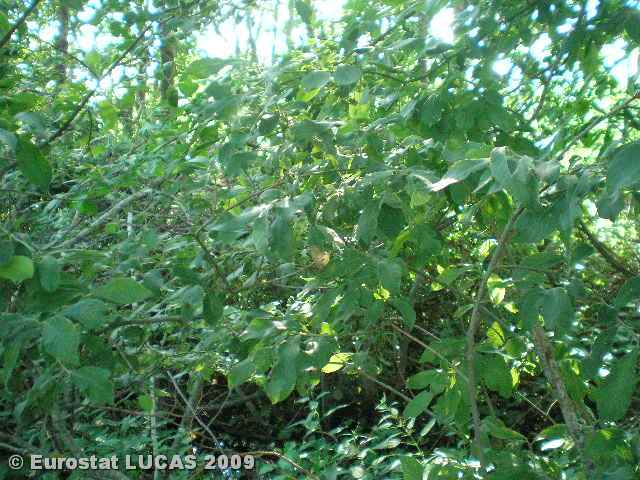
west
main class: Woodland
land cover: Broadleaved woodland
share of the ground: > 75 %
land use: Agriculture (excluding fallow land and kitchen gardens)
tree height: > 5 m
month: July
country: LT
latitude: 54.9609
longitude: 25.5100
